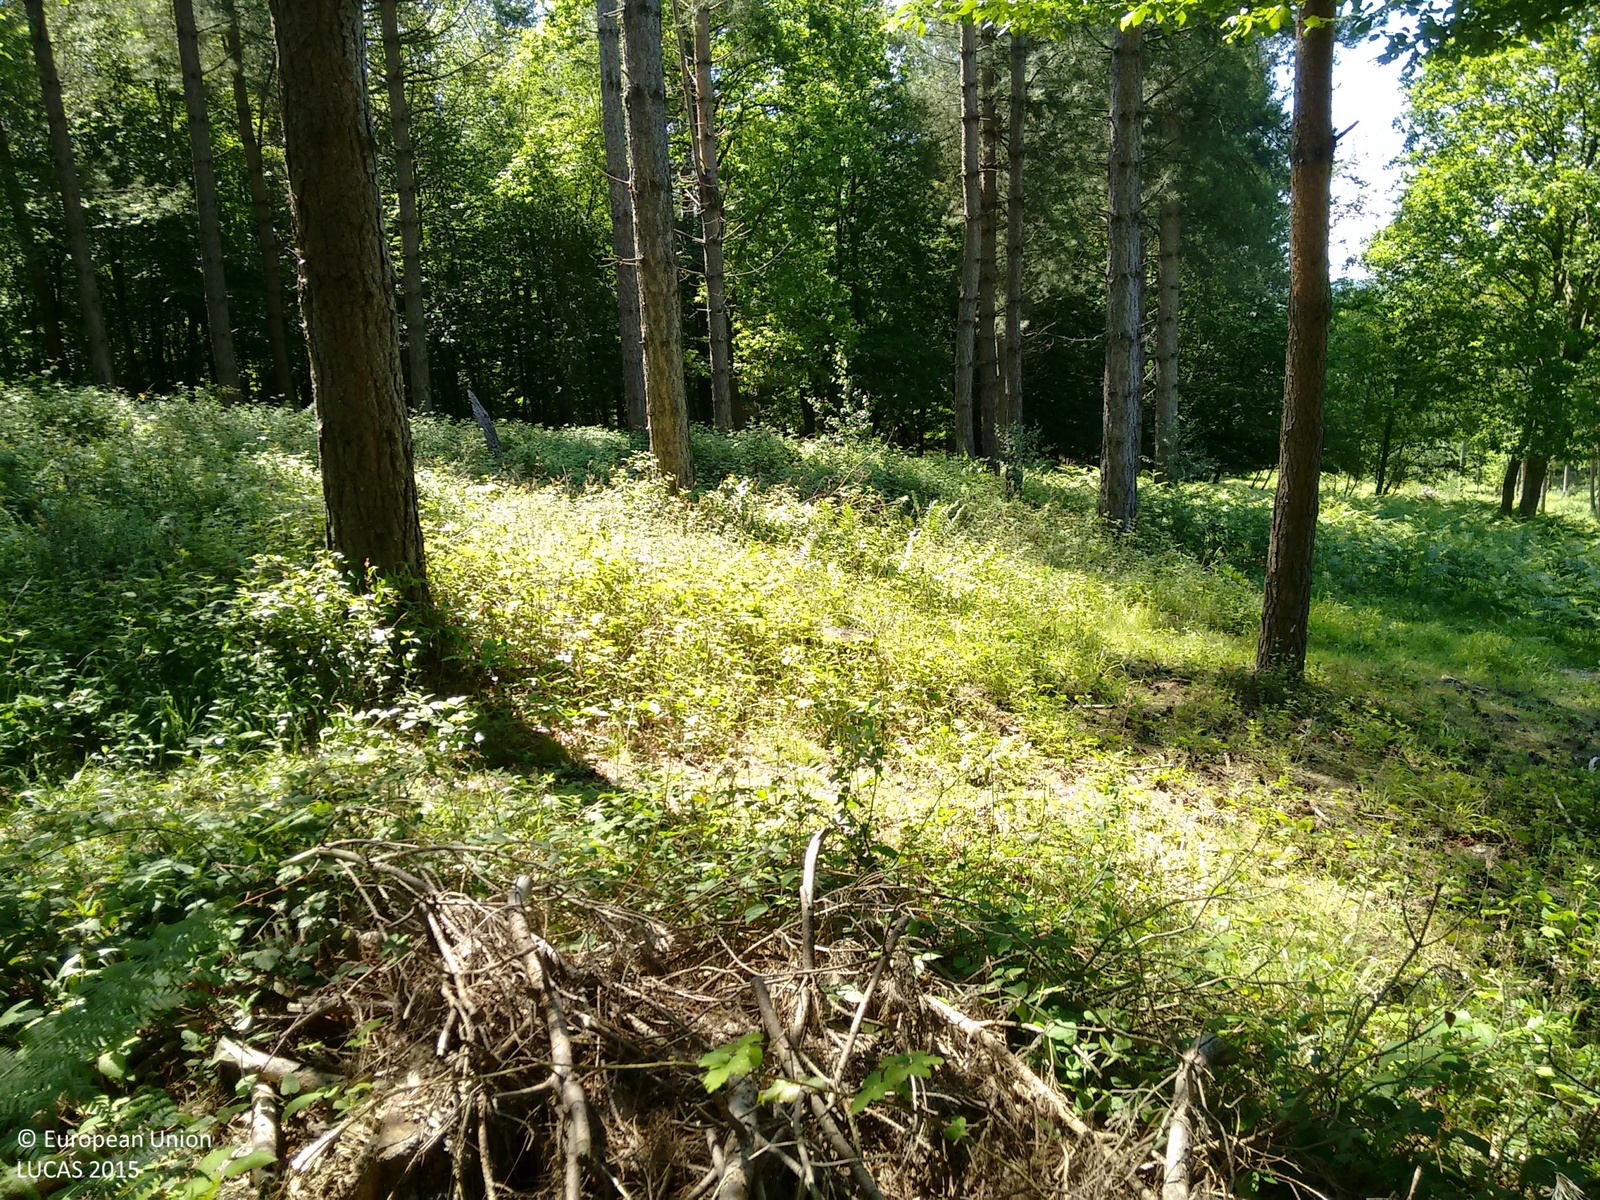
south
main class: Woodland
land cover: Pine dominated coniferous woodland
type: exotic forest
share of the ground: > 75 %
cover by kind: coniferous forest trees 85 %, shrubs 10 %, herbaceous plants 5 %
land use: Forestry
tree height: > 5 m
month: June
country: GB
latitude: 50.9771
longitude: 0.4433
